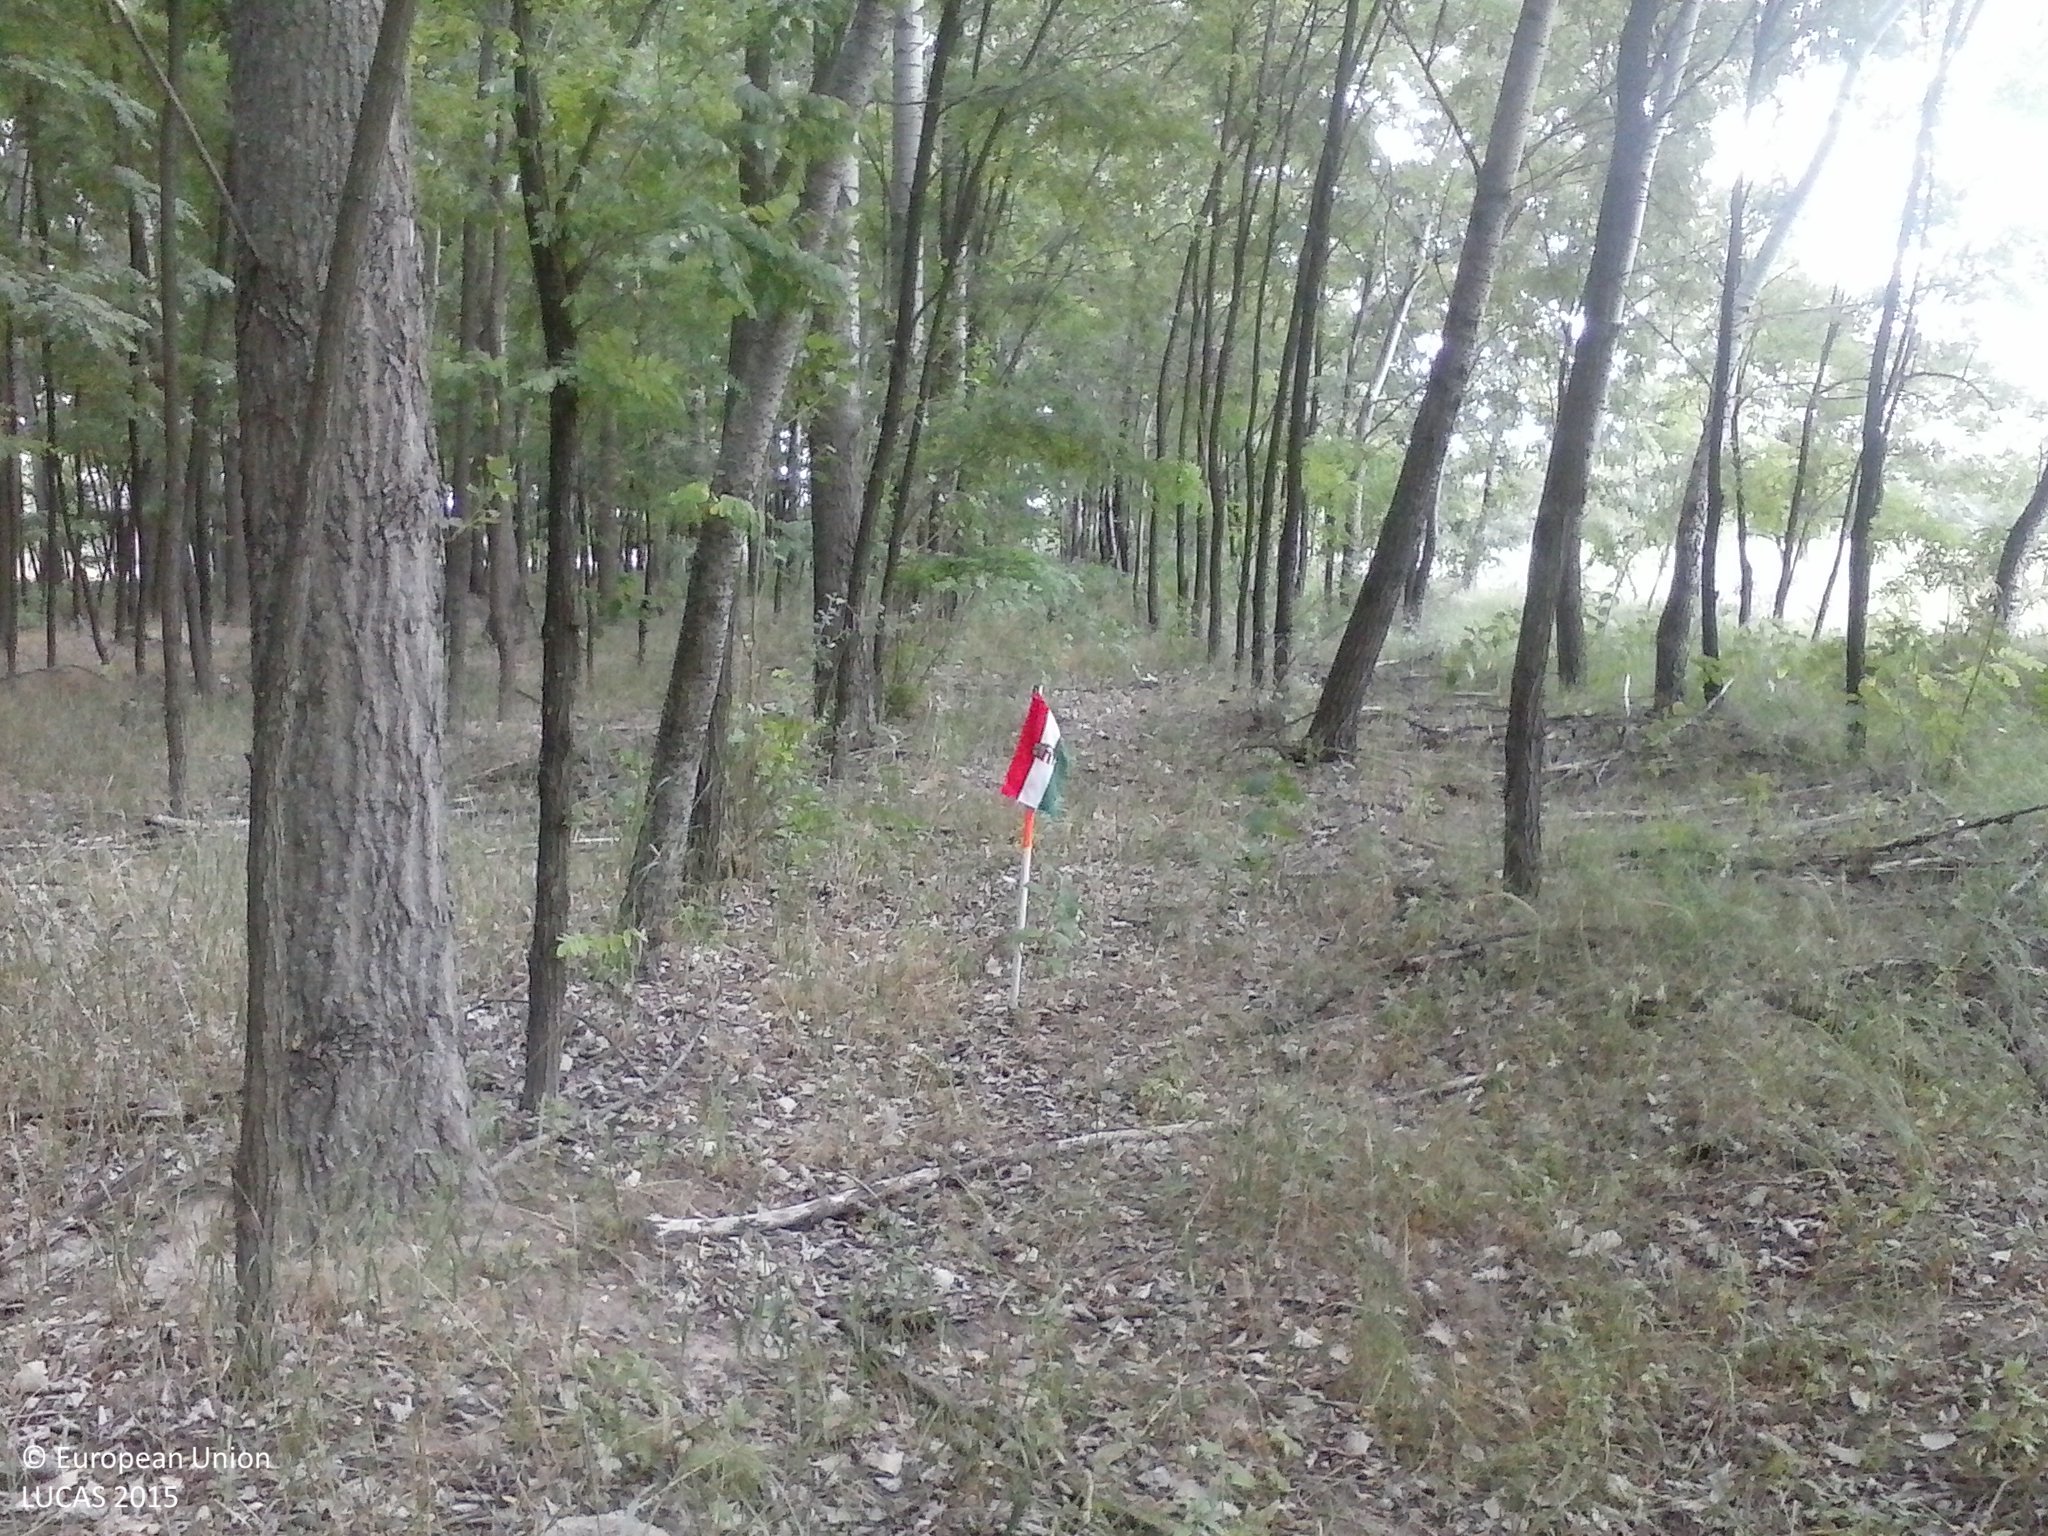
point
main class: Woodland
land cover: Broadleaved woodland
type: mesophytic deciduous forest
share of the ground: > 75 %
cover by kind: broadleaved forest trees 90 %, shrubs 5 %, herbaceous plants 5 %
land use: Forestry
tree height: > 5 m
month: July
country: HU
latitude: 46.6015
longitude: 19.6665
